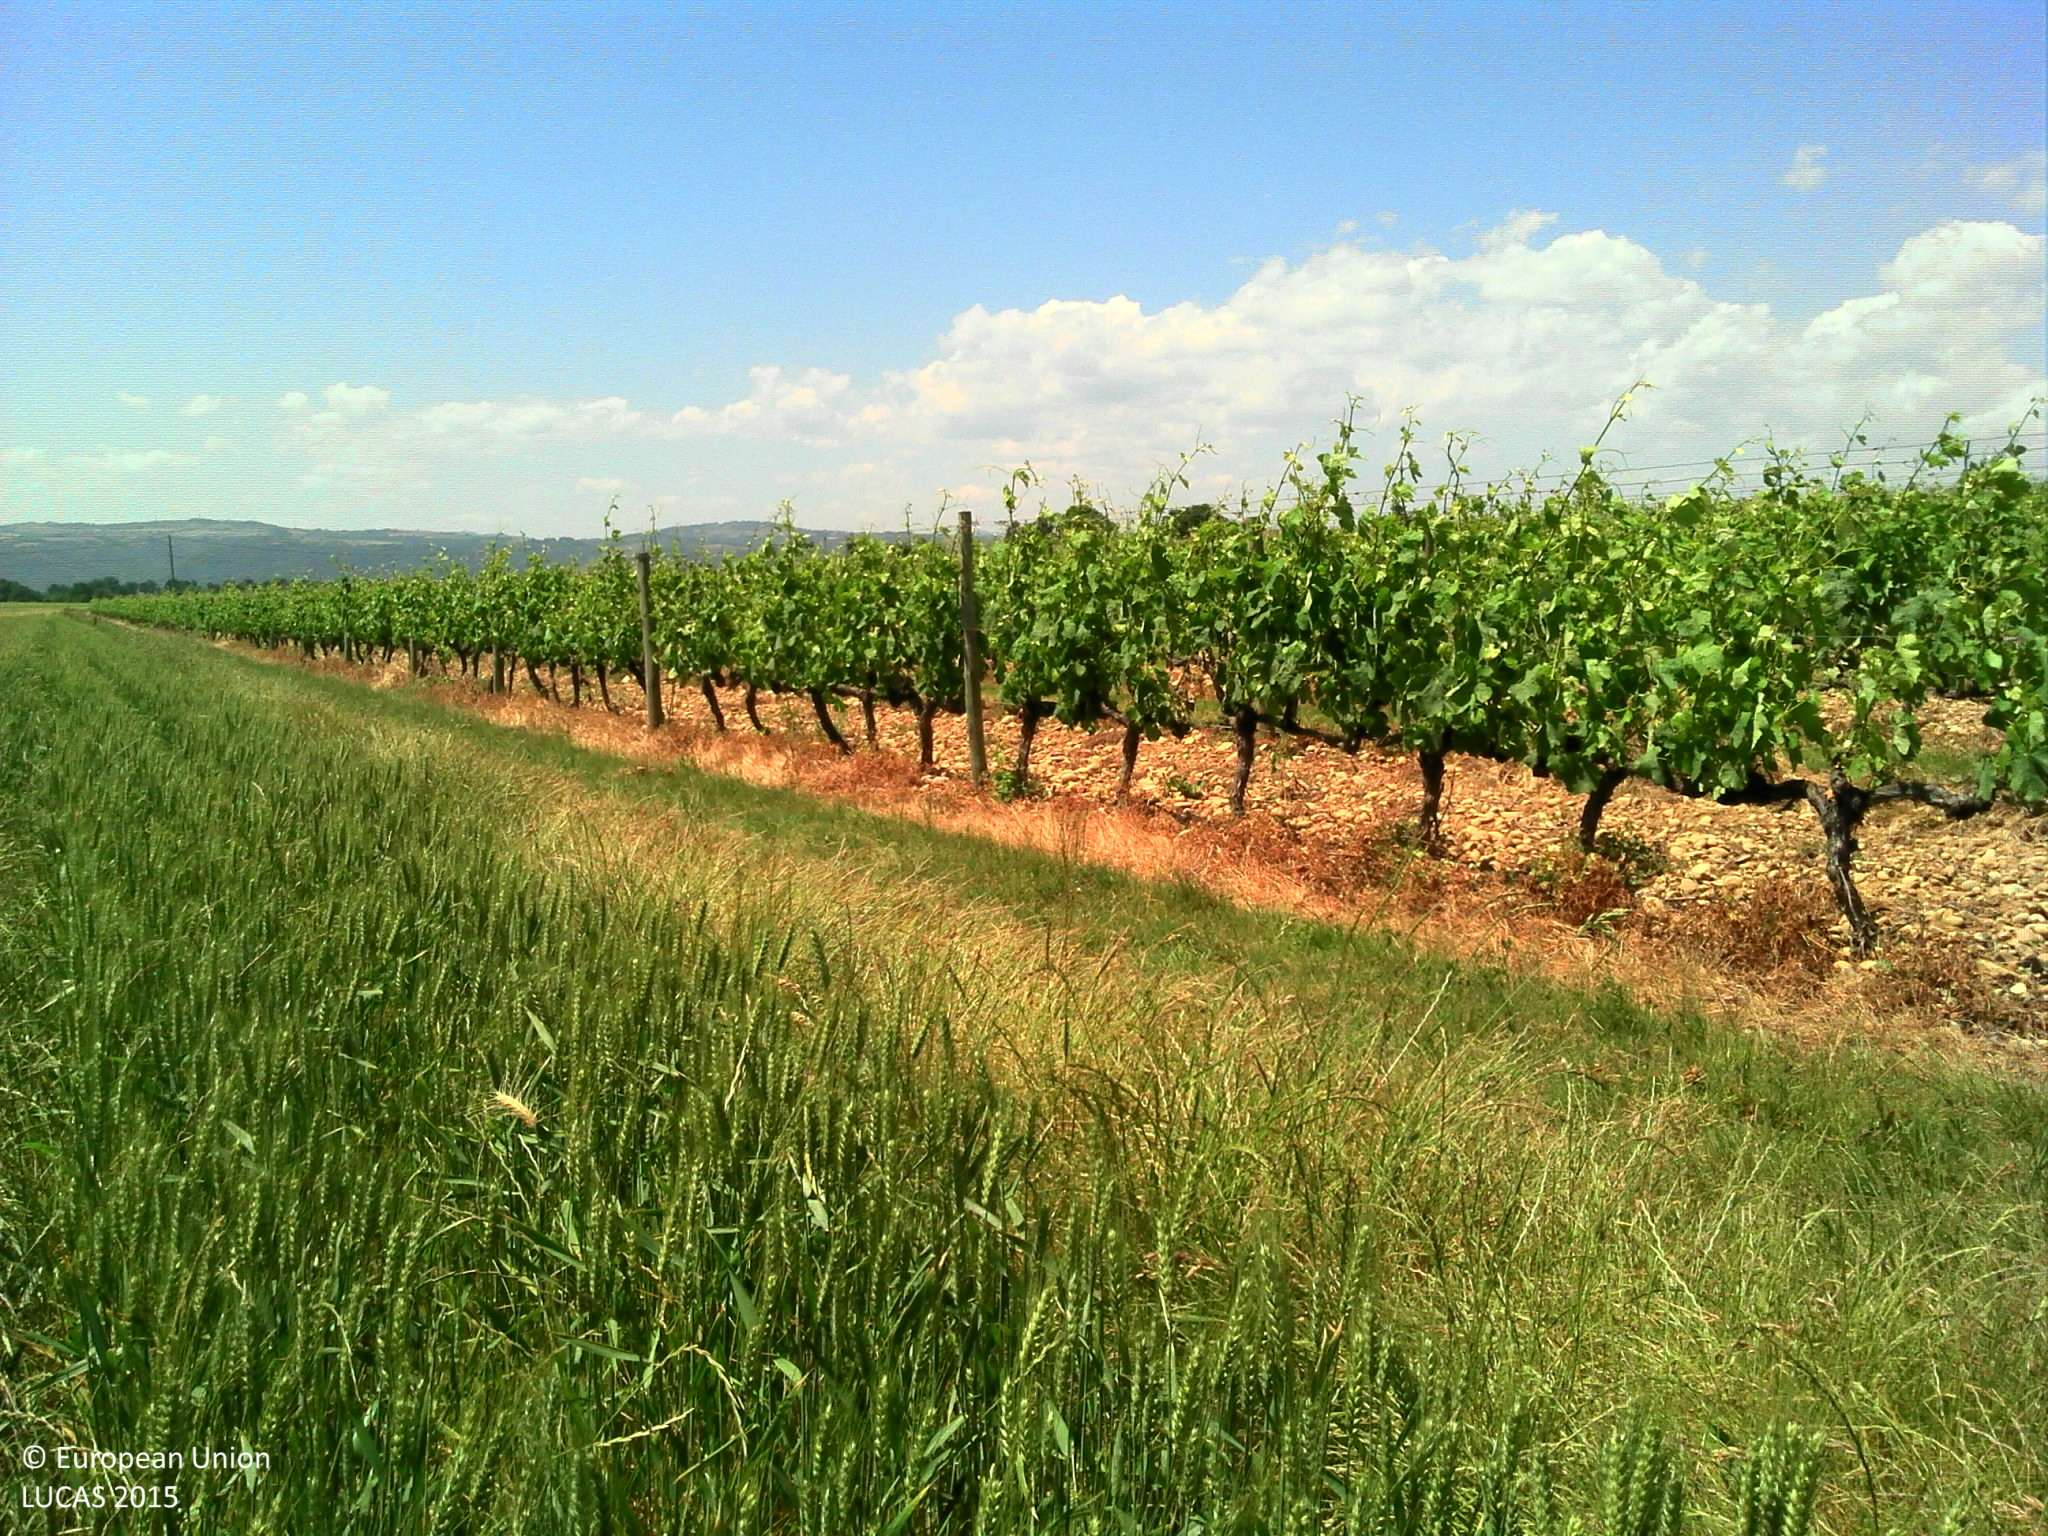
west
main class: Cropland
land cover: Common wheat
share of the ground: > 75 %
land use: Agriculture (excluding fallow land and kitchen gardens)
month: May
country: FR
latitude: 45.0388
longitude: 4.9150
